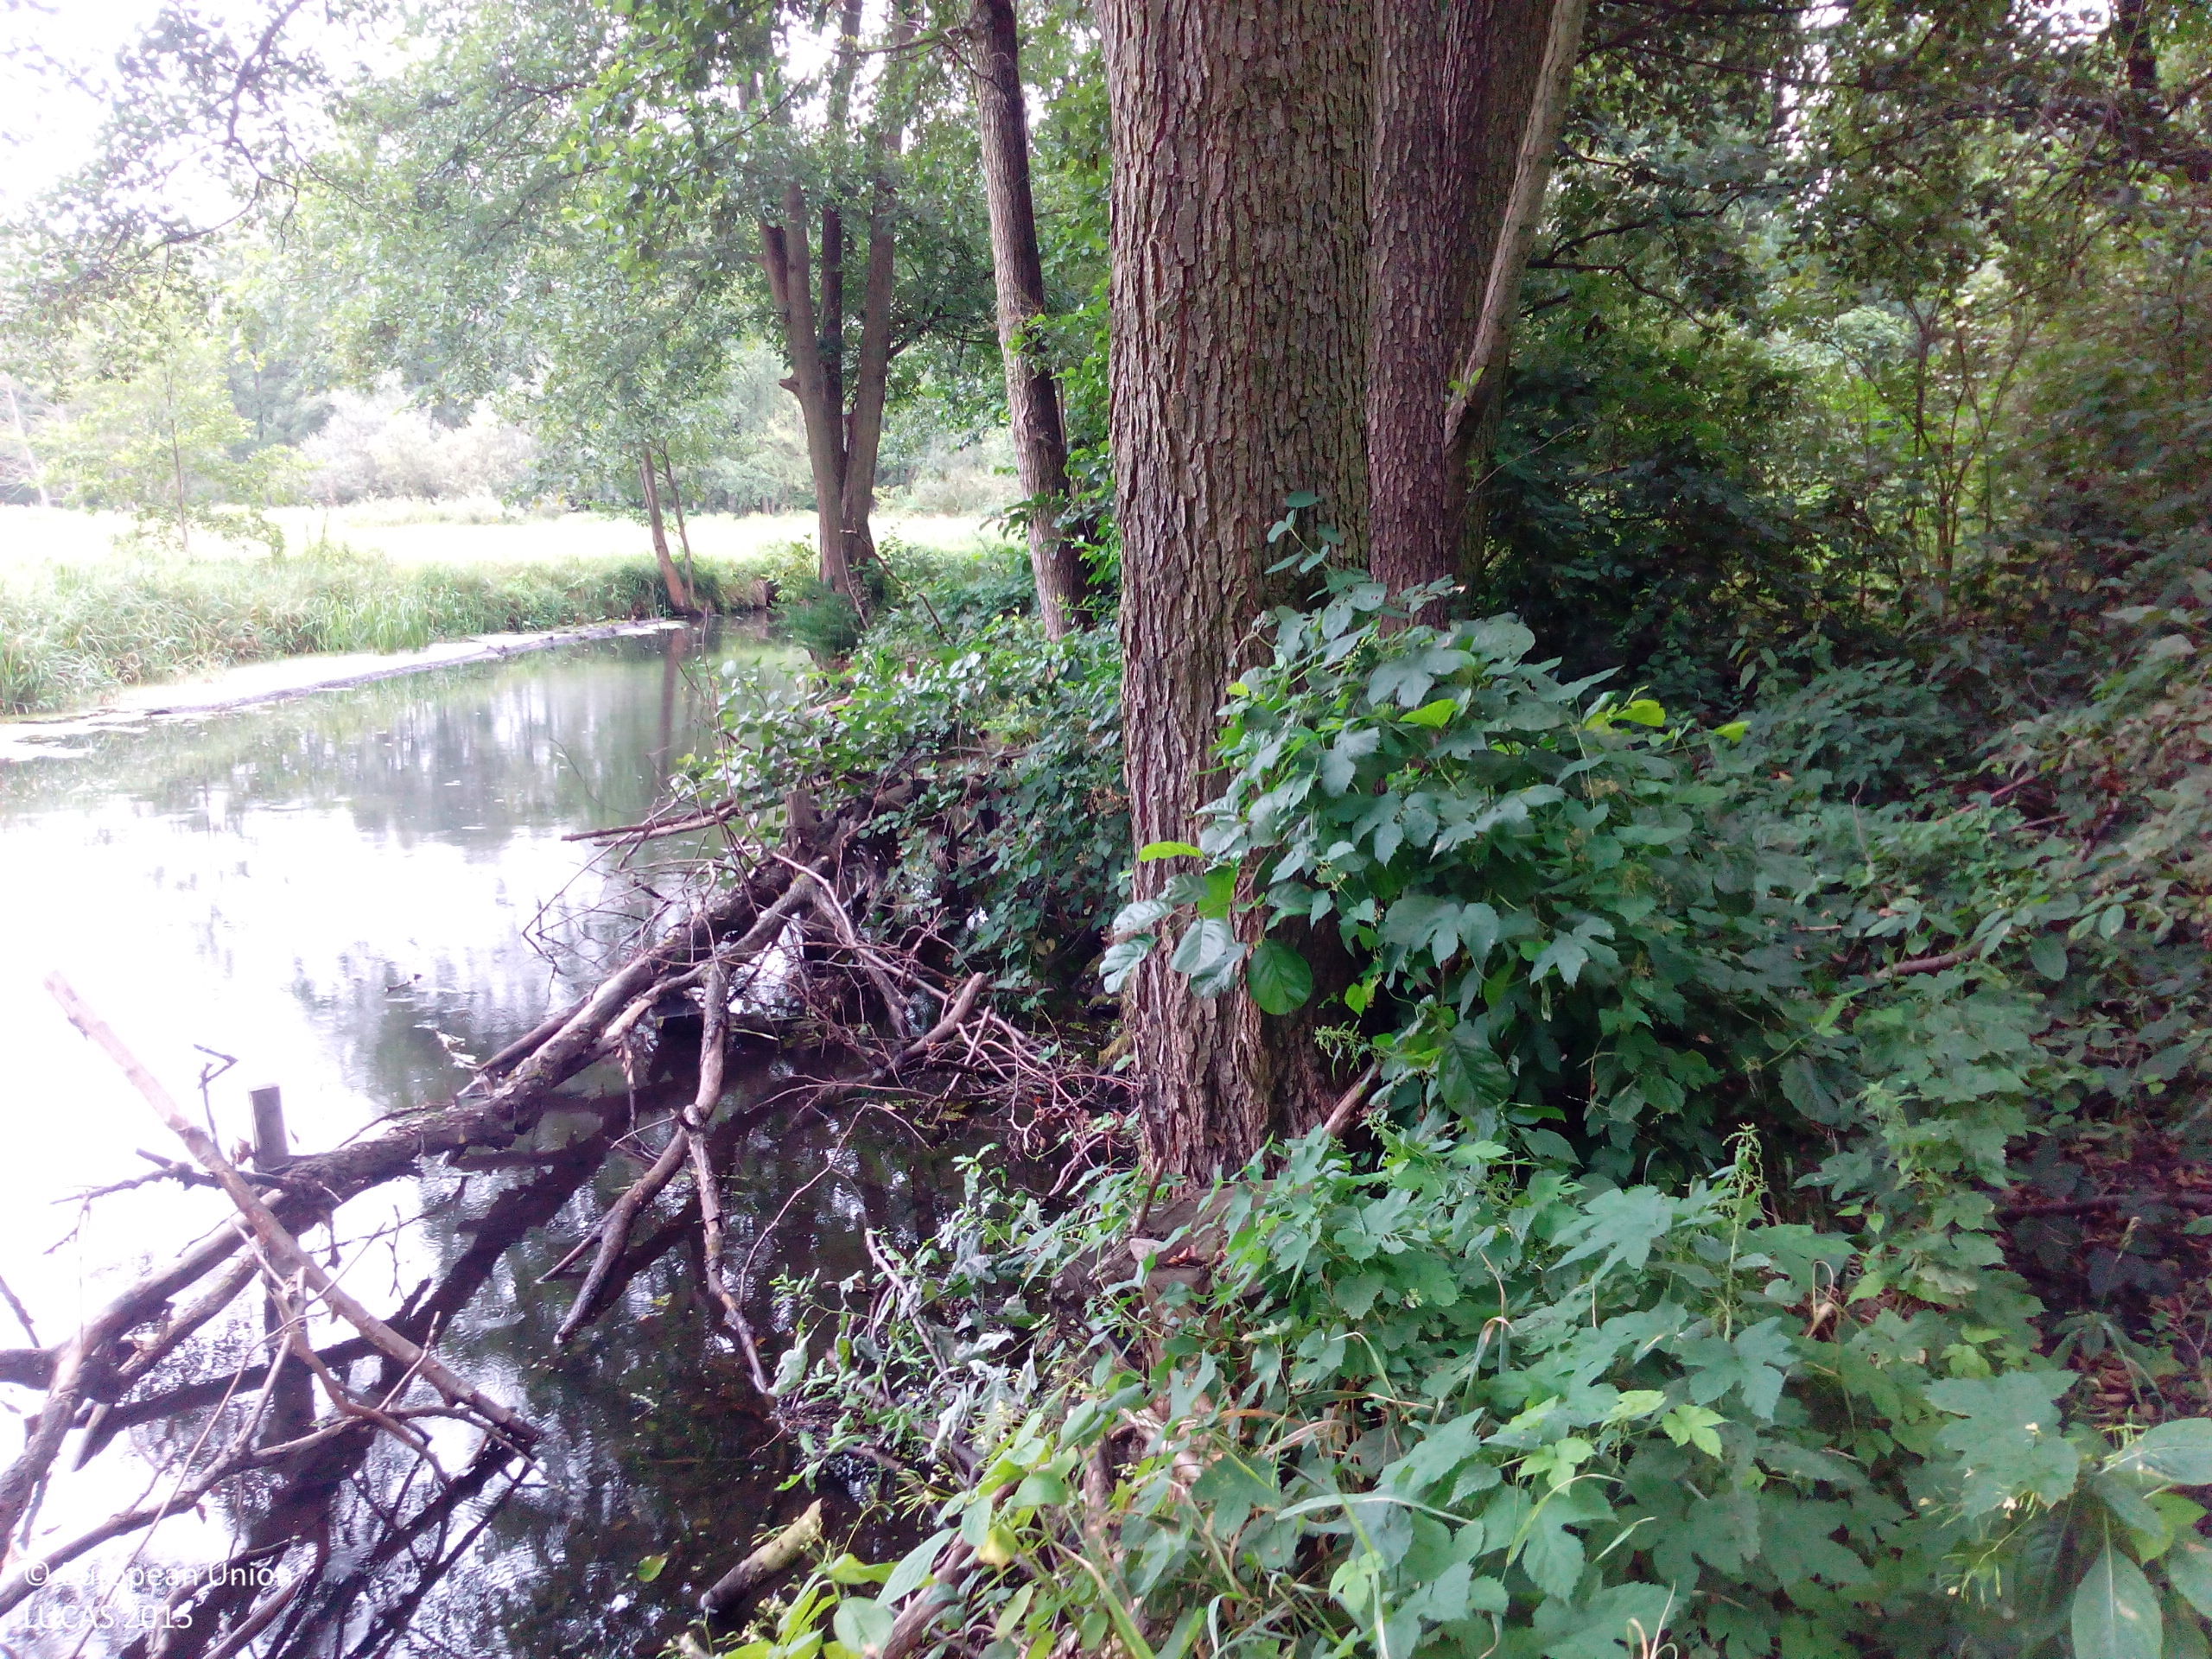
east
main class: Grassland
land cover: Grassland with sparse tree/shrub cover
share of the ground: > 75 %
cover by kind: herbaceous plants 95 %, broadleaved forest trees 5 %
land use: Agriculture (excluding fallow land and kitchen gardens)
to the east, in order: Grassland with sparse tree/shrub cover; Grassland without tree/shrub cover; Broadleaved woodland; Inland fresh running water; Broadleaved woodland; Tracks; Managed hedges; Inland marshes; Single bushes/trees; Inland marshes
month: August
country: DE
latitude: 51.8943
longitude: 14.0553
